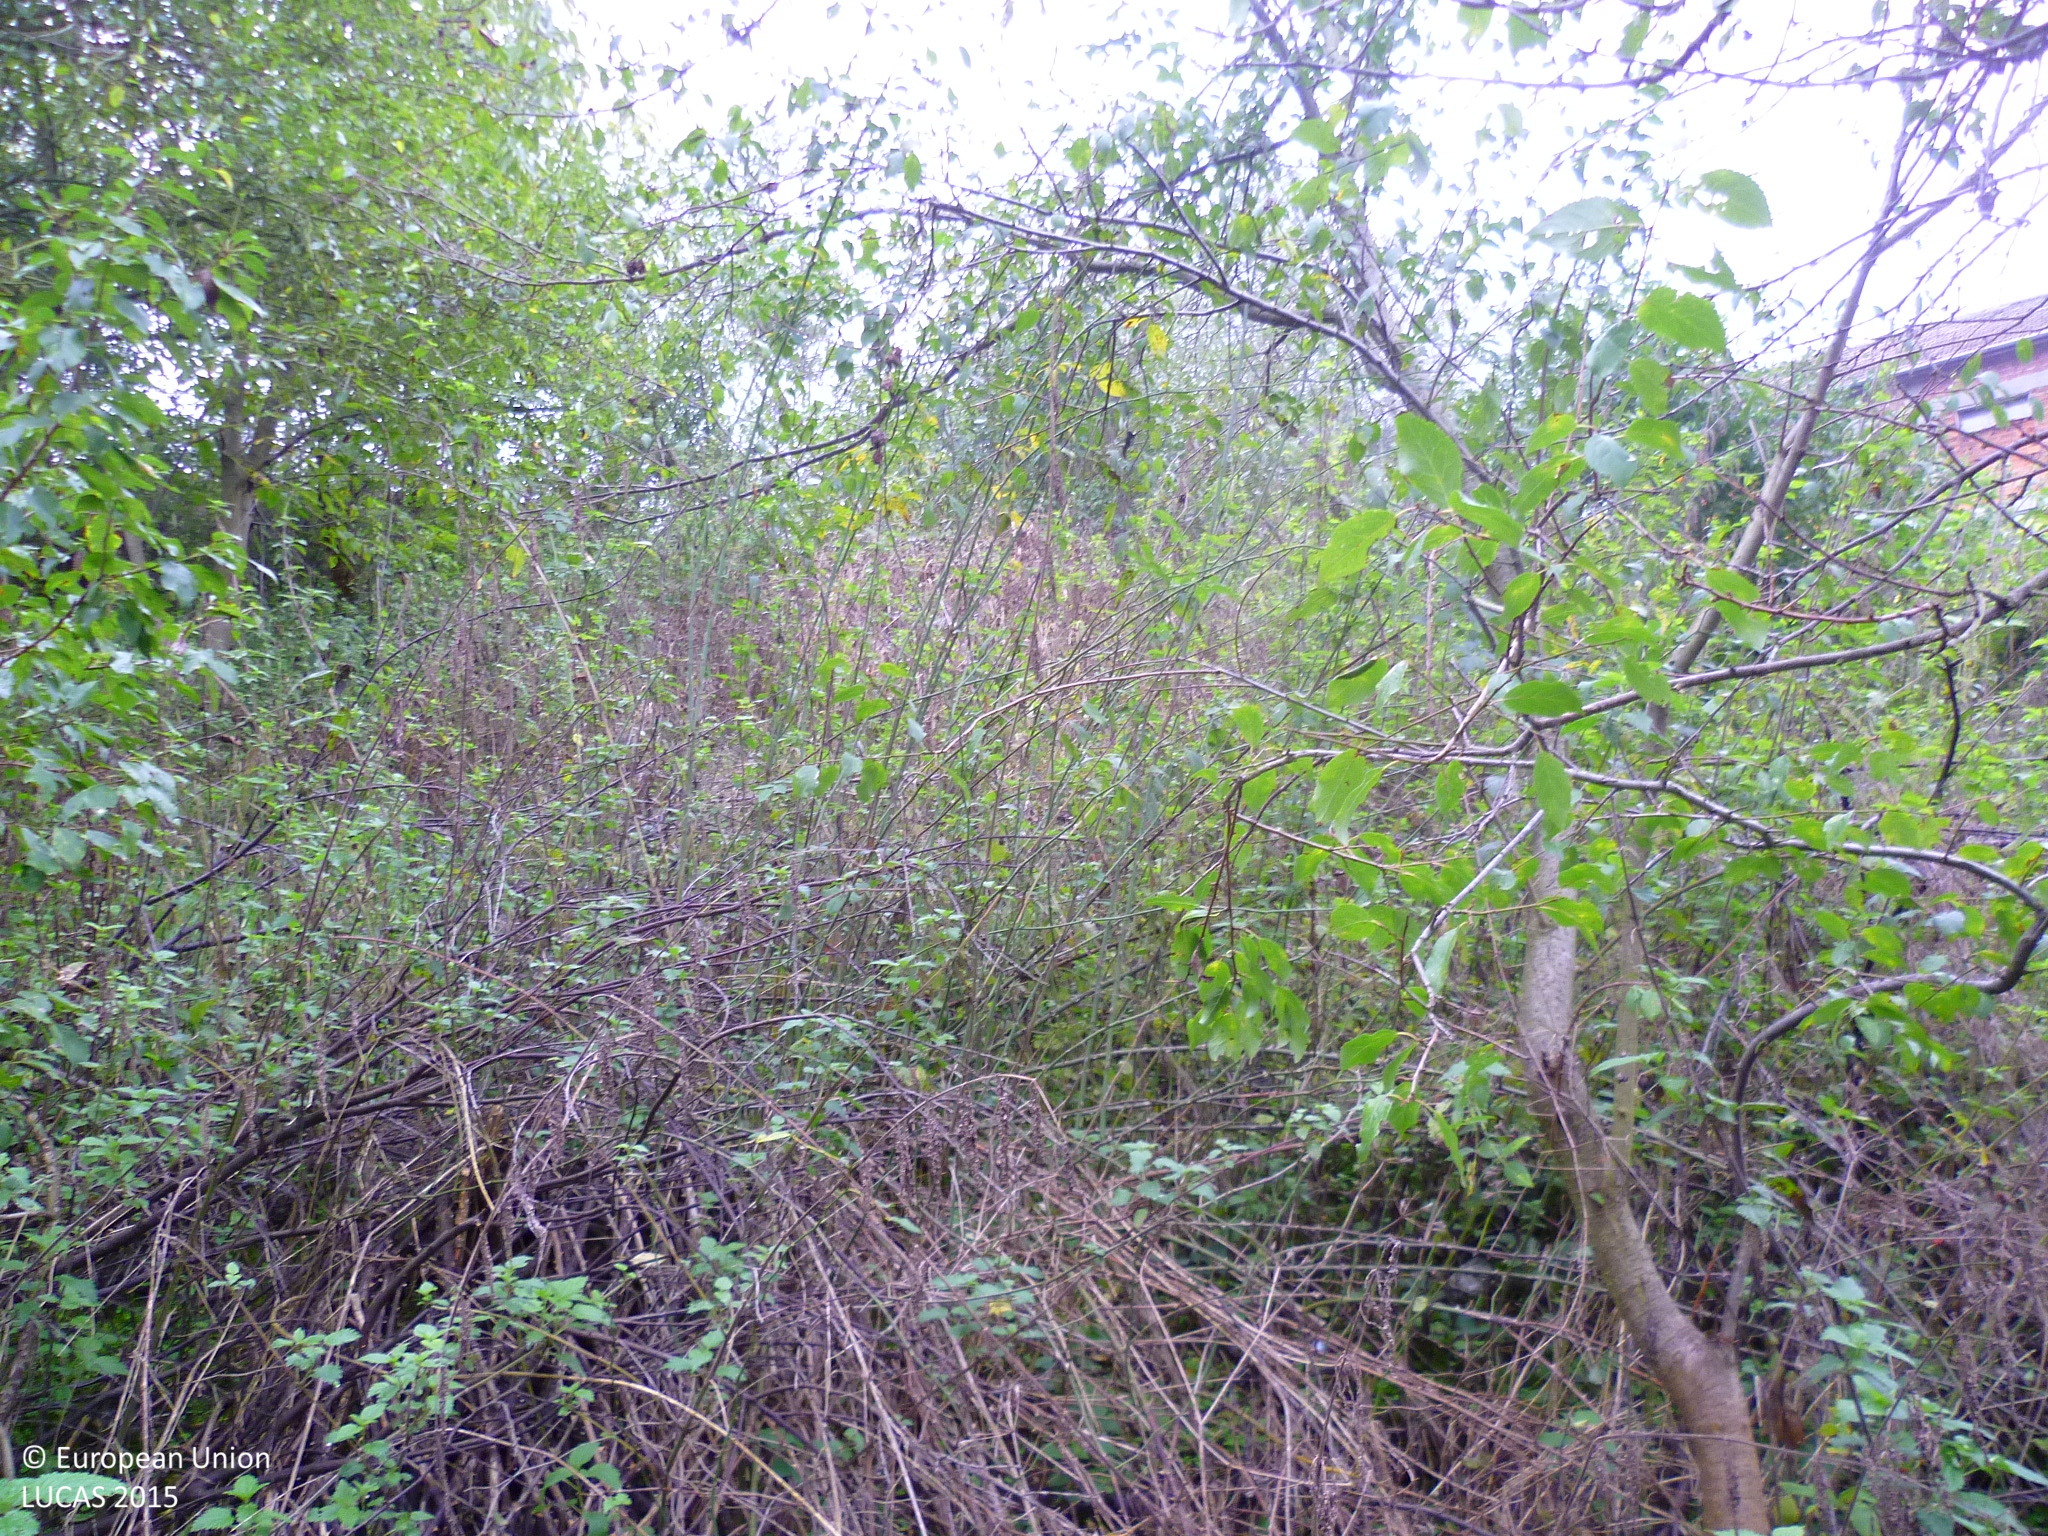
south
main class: Cropland
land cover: Pear fruit
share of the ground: 10 - 25 %
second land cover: Shrubland without tree cover
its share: 50 - 75 %
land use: Abandoned areas
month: October
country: BG
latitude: 42.3963
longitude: 23.5559
